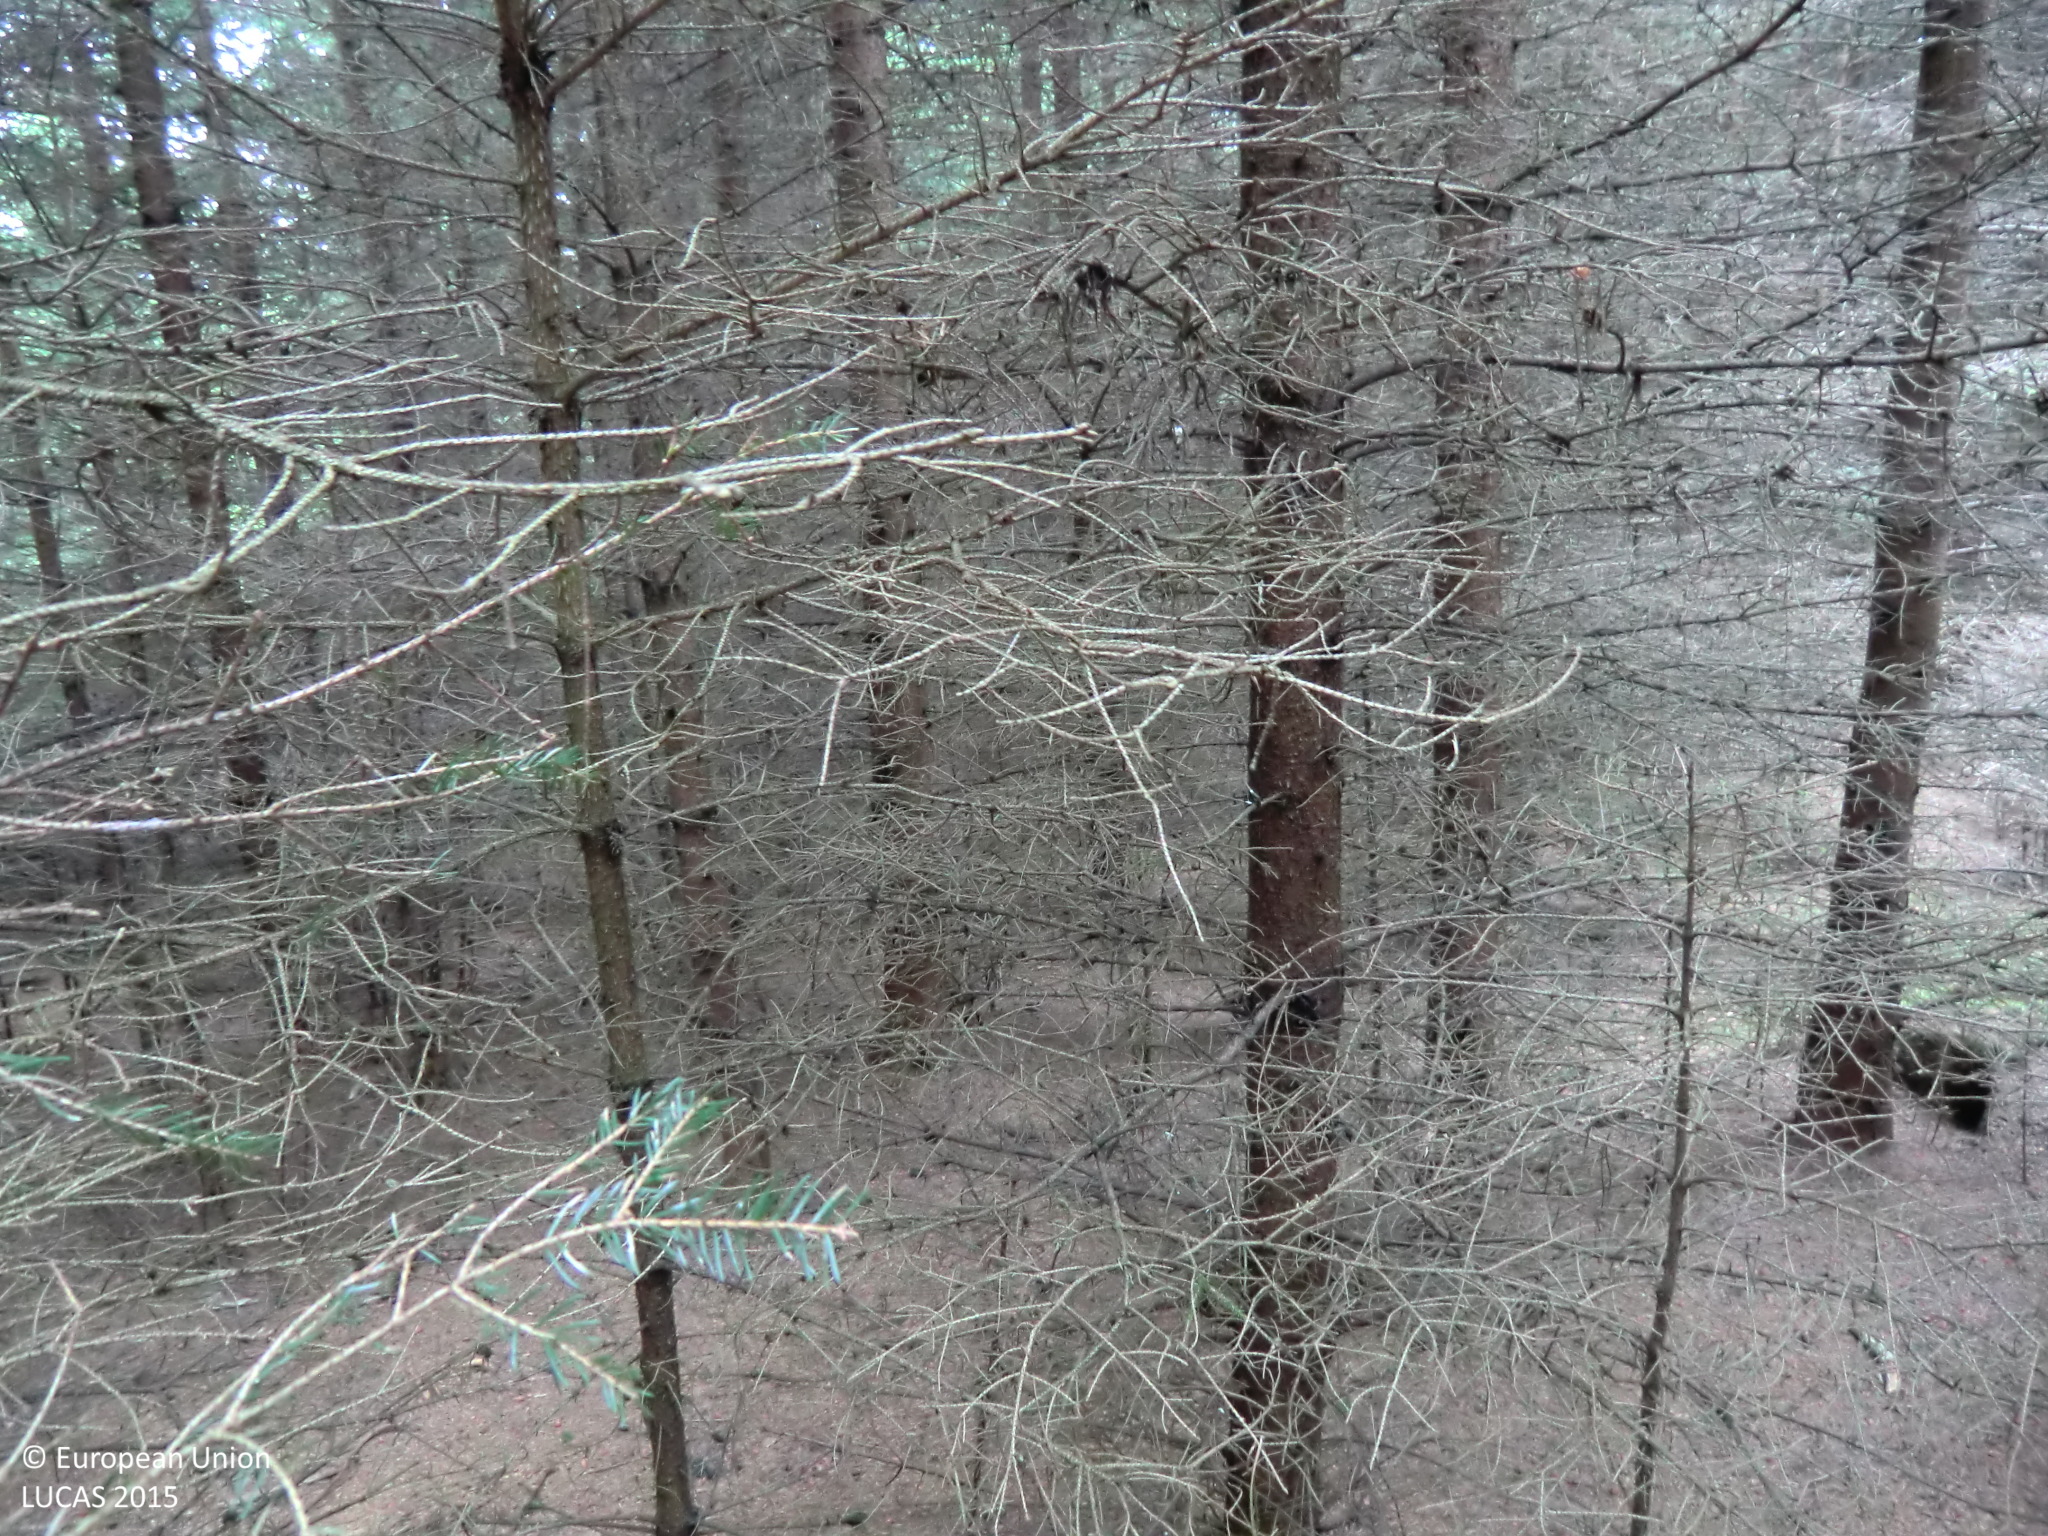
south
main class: Woodland
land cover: Spruce dominated coniferous woodland
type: hemiboreal forest and nemoral coniferous forest and mixed broadleaved-coniferous forest
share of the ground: > 75 %
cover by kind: coniferous forest trees 90 %, unconsolidated bare surface 10 %
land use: Forestry
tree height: > 5 m
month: June
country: AT
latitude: 48.5954
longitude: 15.0322
